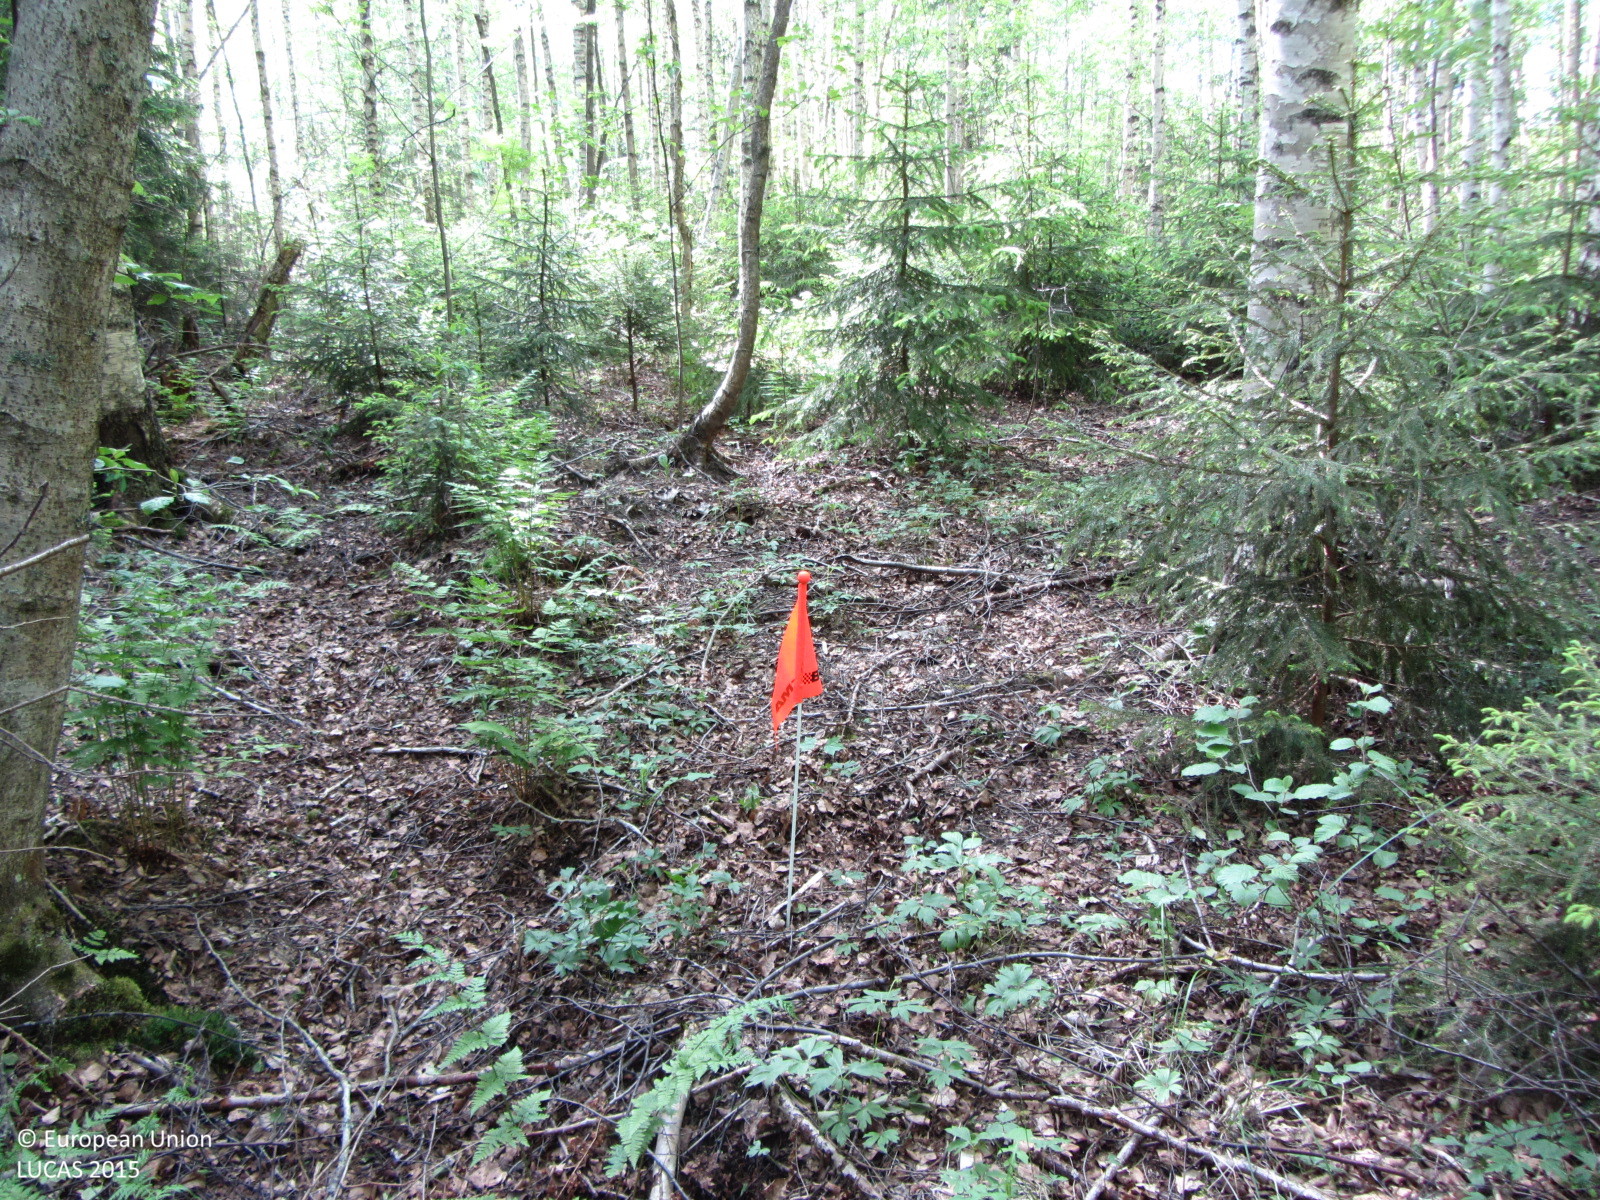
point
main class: Woodland
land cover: Broadleaved woodland
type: boreal forest
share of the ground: > 75 %
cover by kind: broadleaved forest trees 85 %, coniferous forest trees 10 %, herbaceous plants 5 %
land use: Forestry
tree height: > 5 m
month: June
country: FI
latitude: 60.2937
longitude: 24.2680
